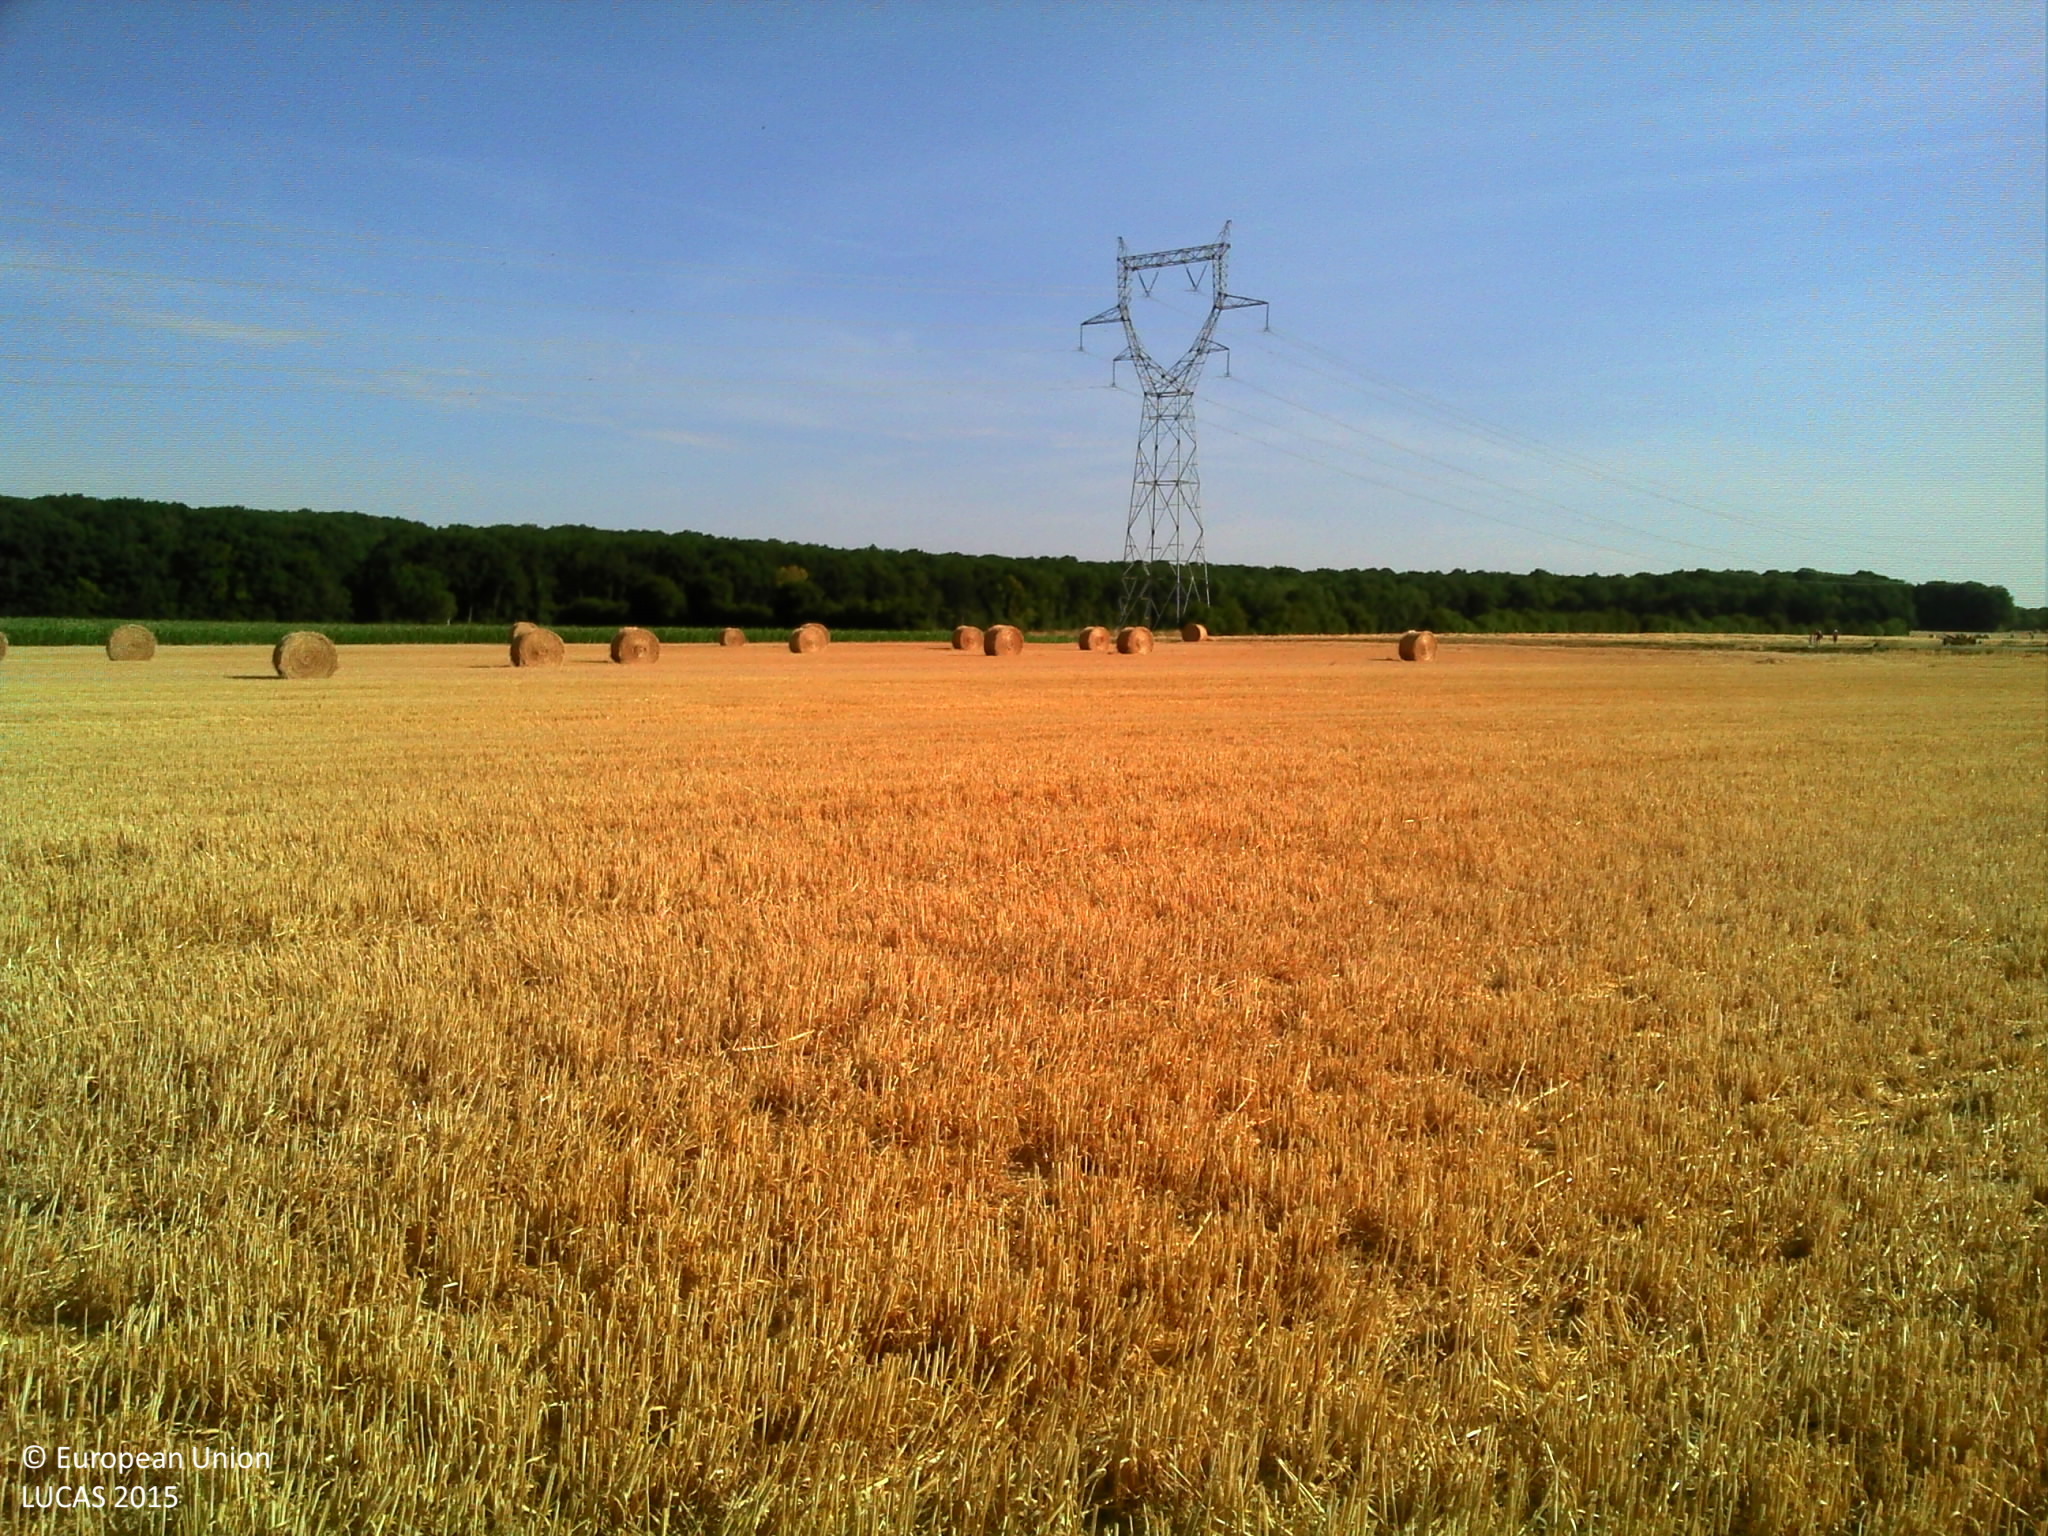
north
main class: Cropland
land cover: Barley
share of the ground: > 75 %
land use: Agriculture (excluding fallow land and kitchen gardens)
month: July
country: FR
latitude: 48.4946
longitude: 6.0351
